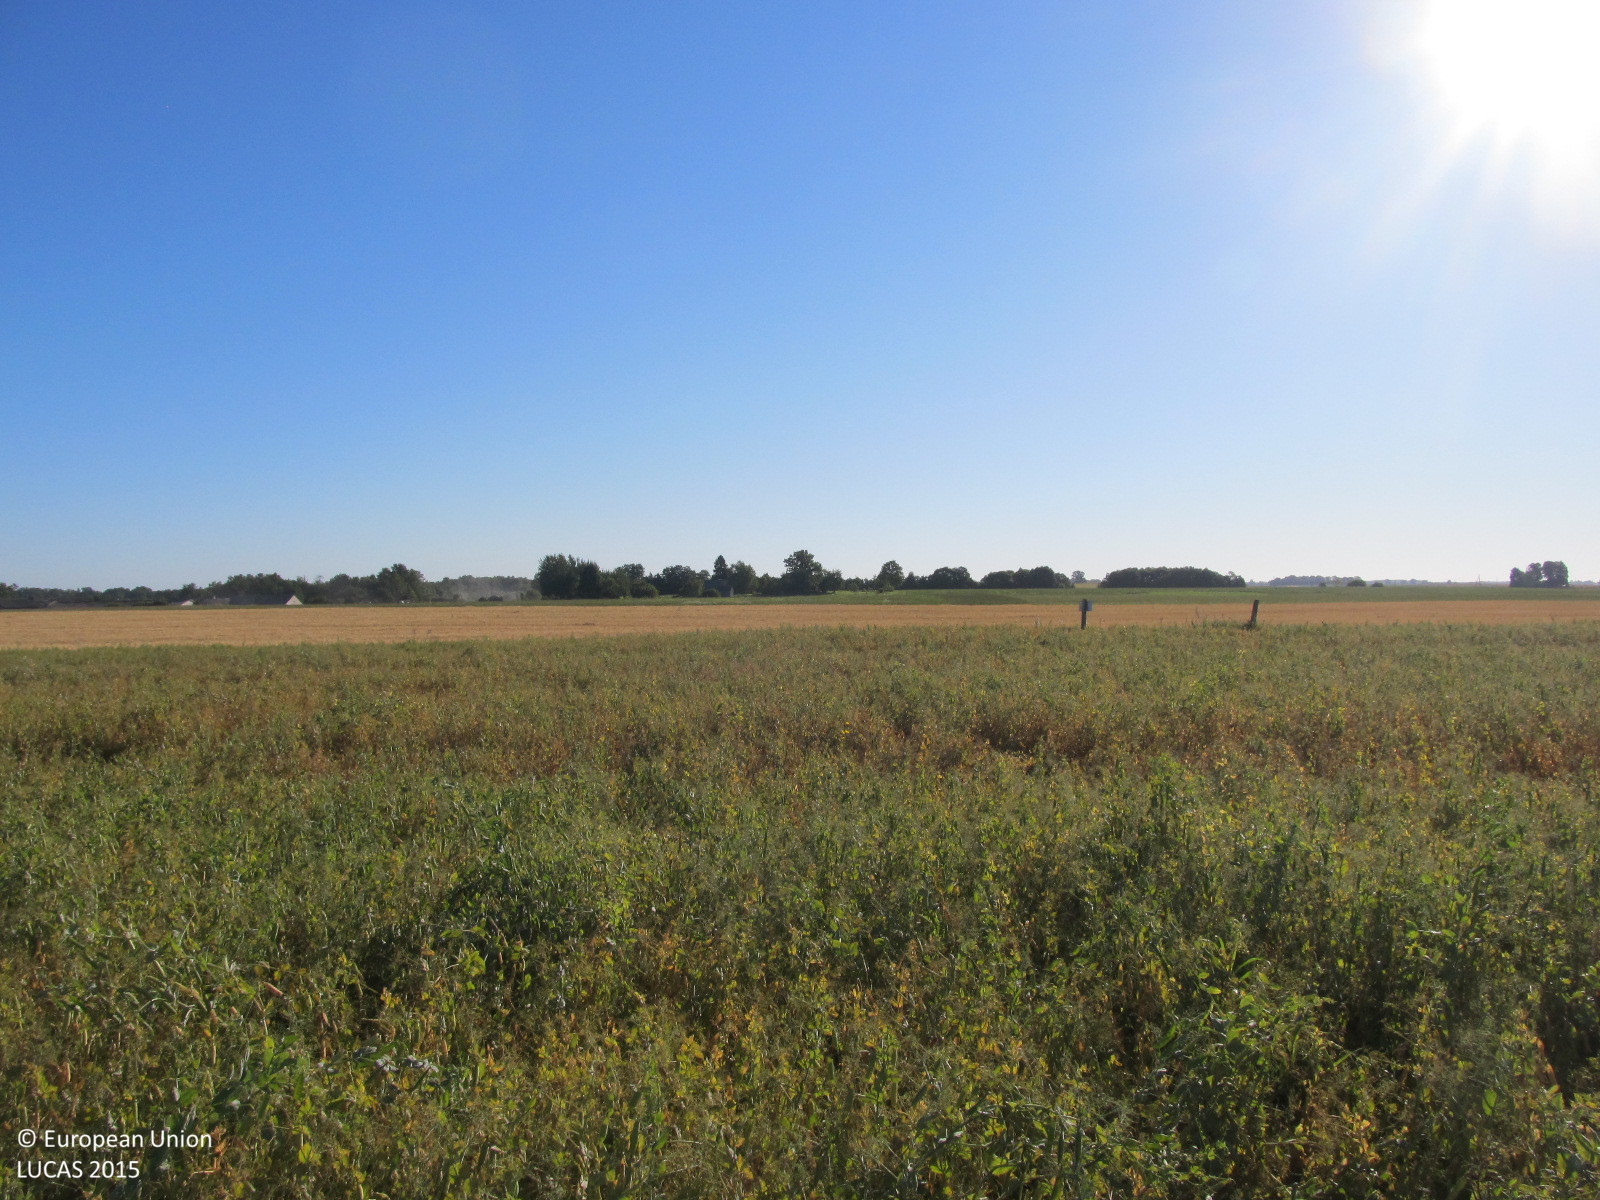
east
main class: Cropland
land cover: Dry pulses
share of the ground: > 75 %
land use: Agriculture (excluding fallow land and kitchen gardens)
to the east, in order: Dry pulses; Barley; Fences; Grassland without tree/shrub cover
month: August
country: LT
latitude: 56.3346
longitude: 22.7267
